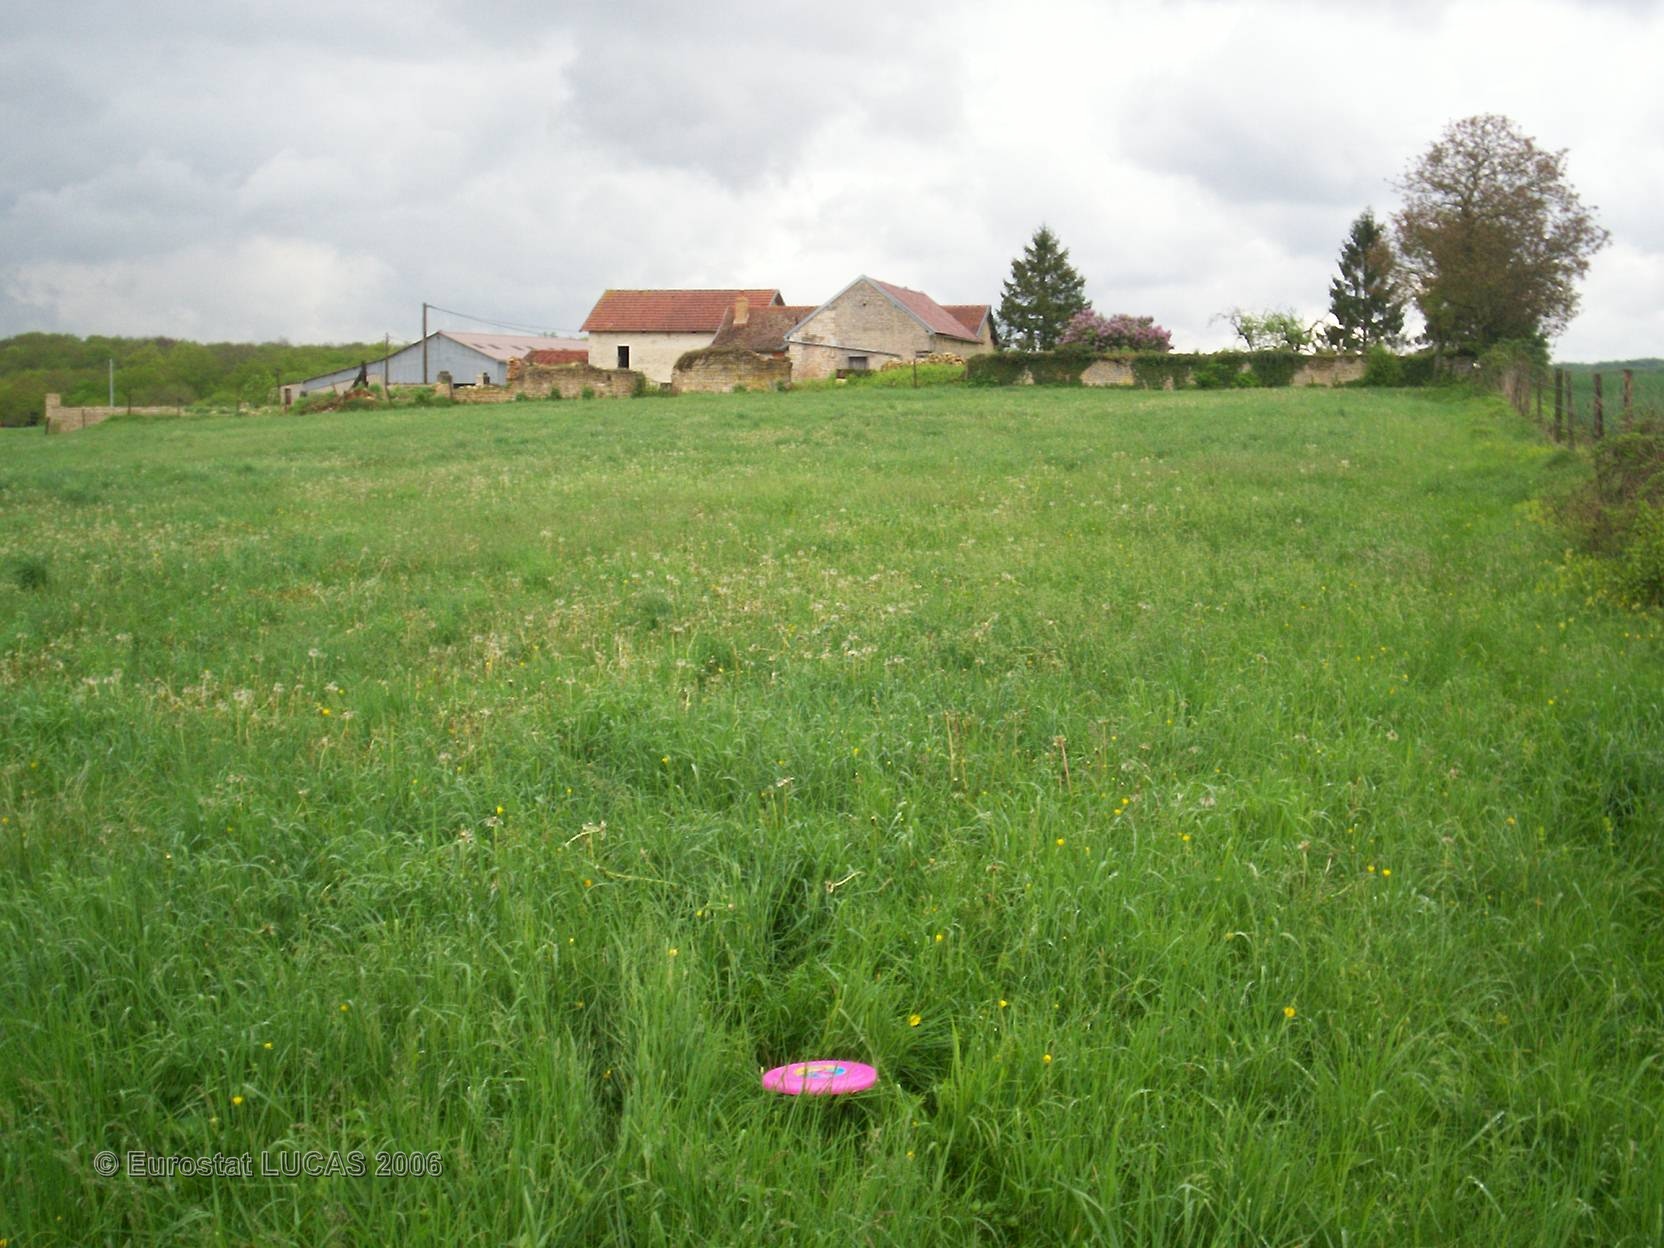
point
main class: Grassland
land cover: Grassland without tree/shrub cover
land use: Agriculture (excluding fallow land and kitchen gardens)
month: May
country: FR
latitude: 47.7816
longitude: 4.5399
